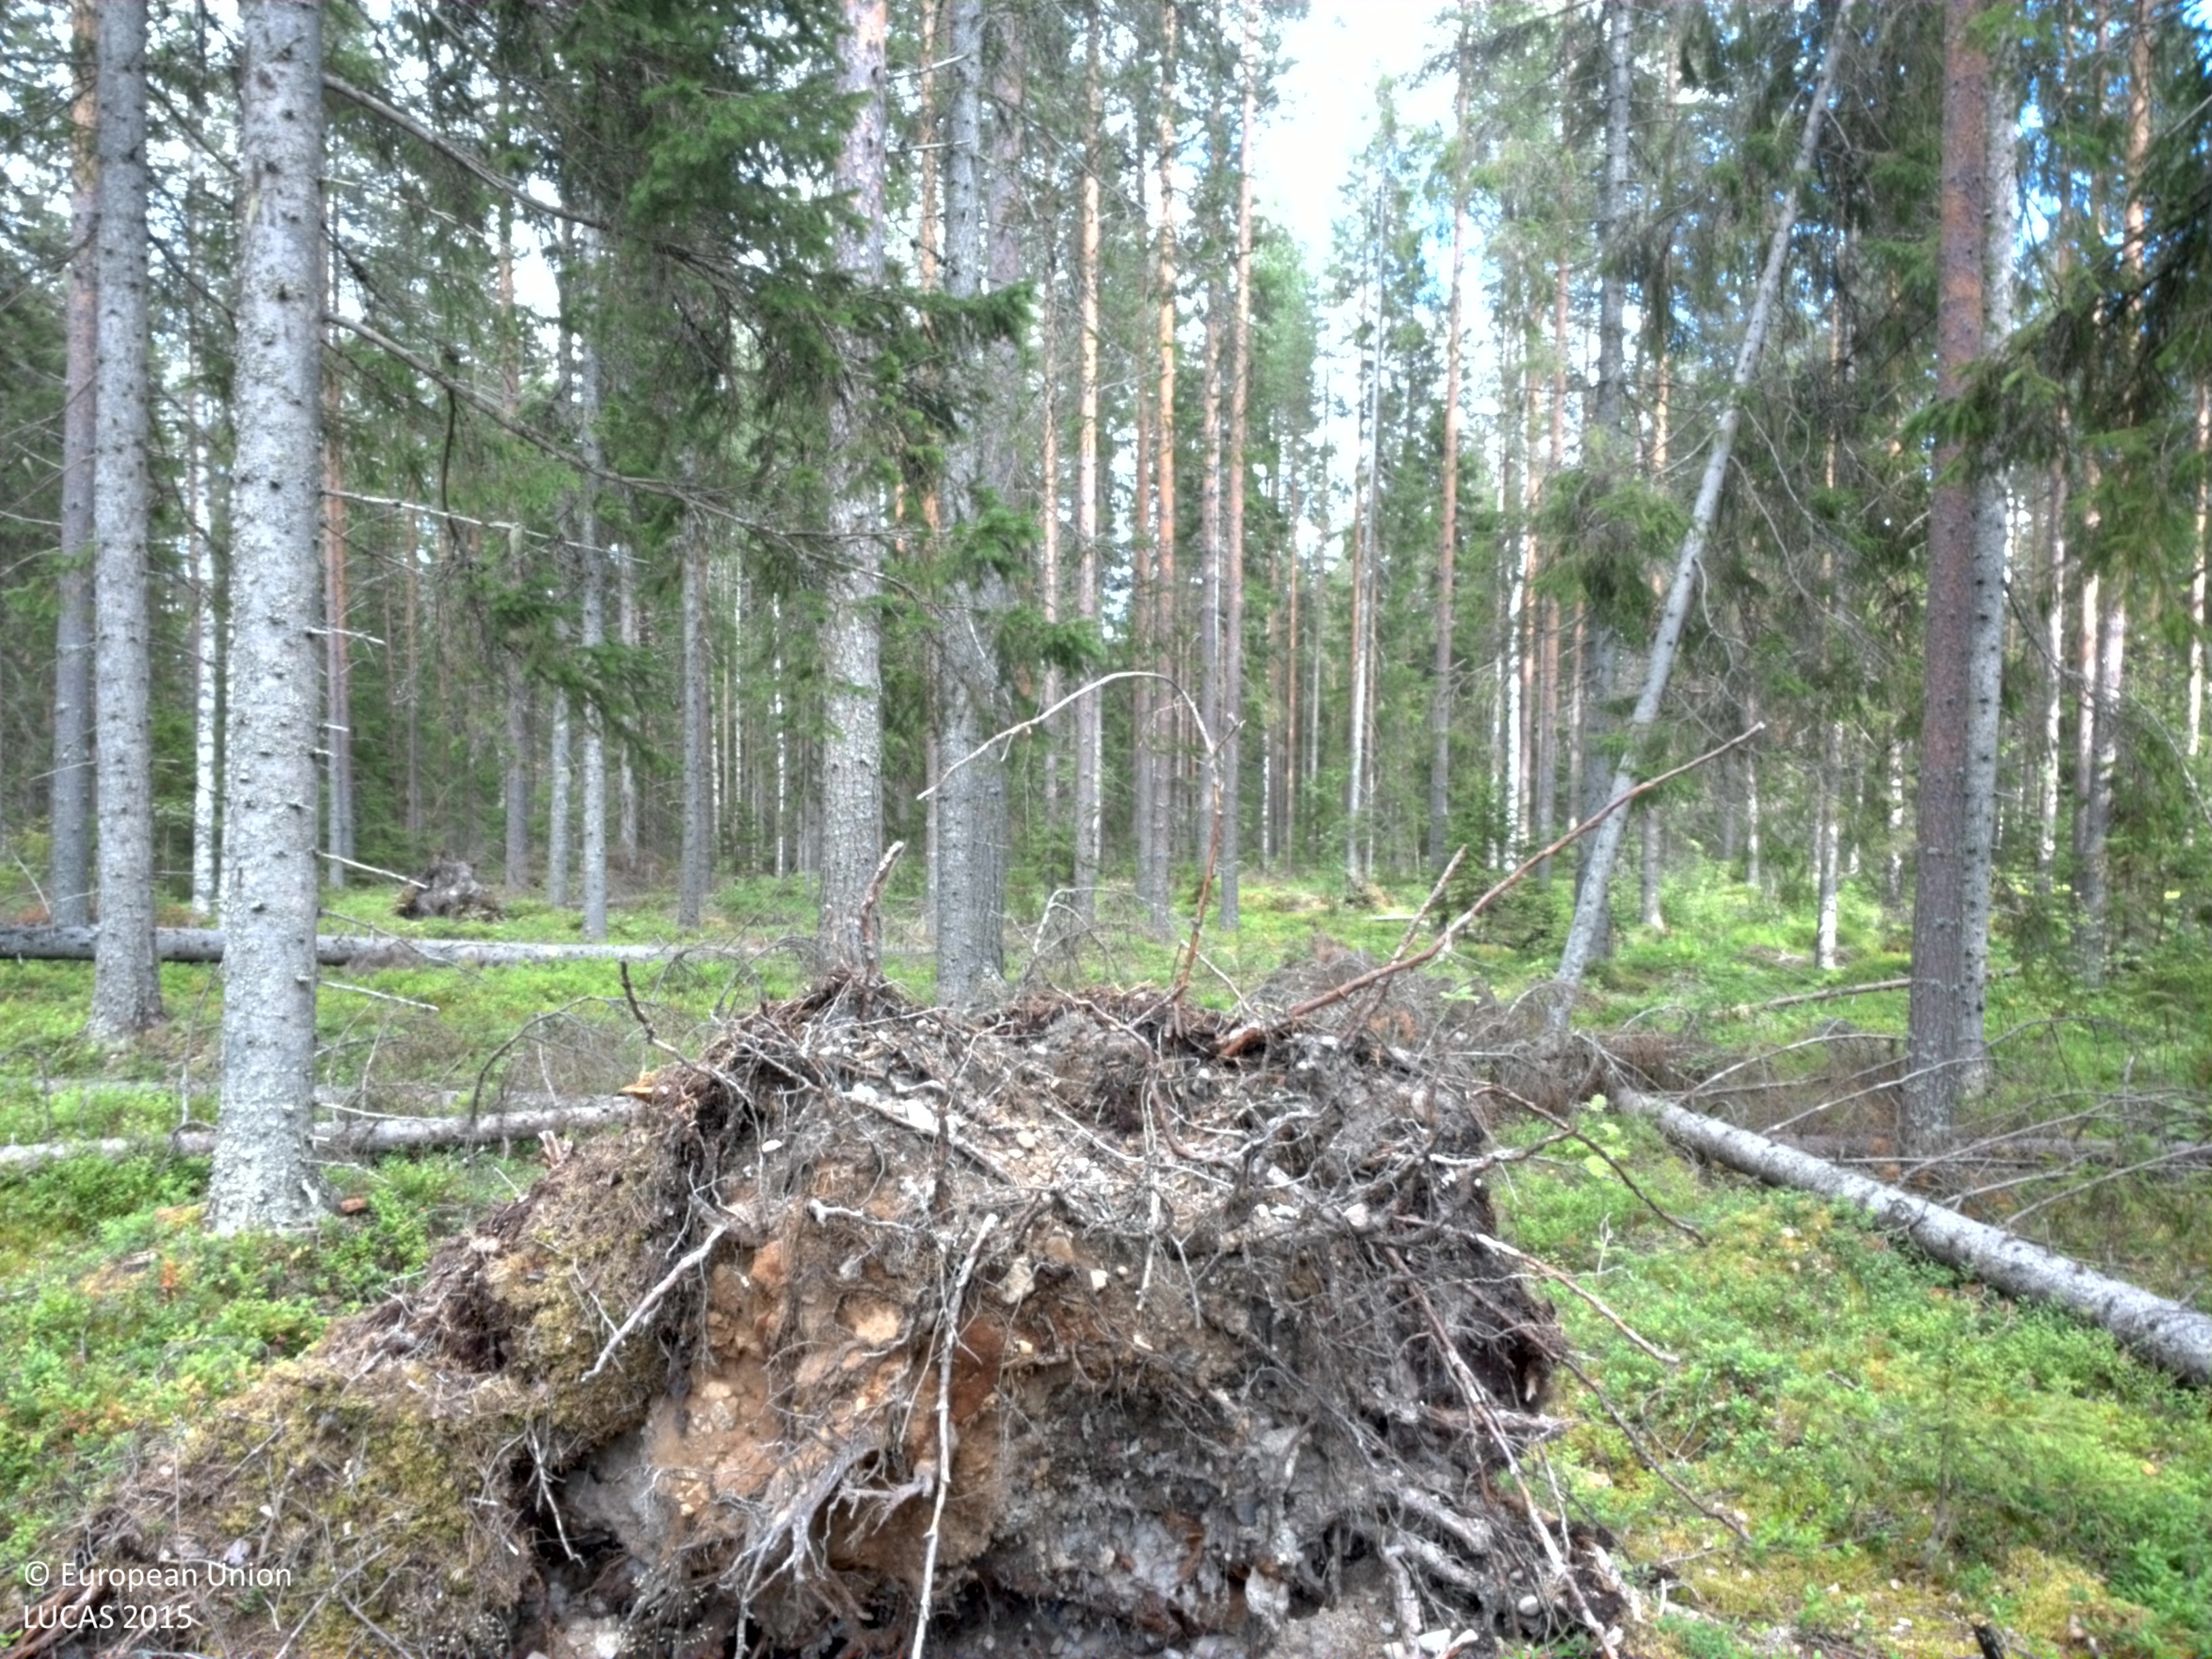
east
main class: Woodland
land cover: Pine dominated coniferous woodland
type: boreal forest
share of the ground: 50 - 75 %
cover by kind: coniferous forest trees 60 %, shrubs 30 %, broadleaved forest trees 5 %, lichens and mosses 5 %
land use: Forestry
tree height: > 5 m
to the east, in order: Pine dominated coniferous woodland; Spruce dominated coniferous woodland
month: August
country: SE
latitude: 64.6113
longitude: 20.8274
